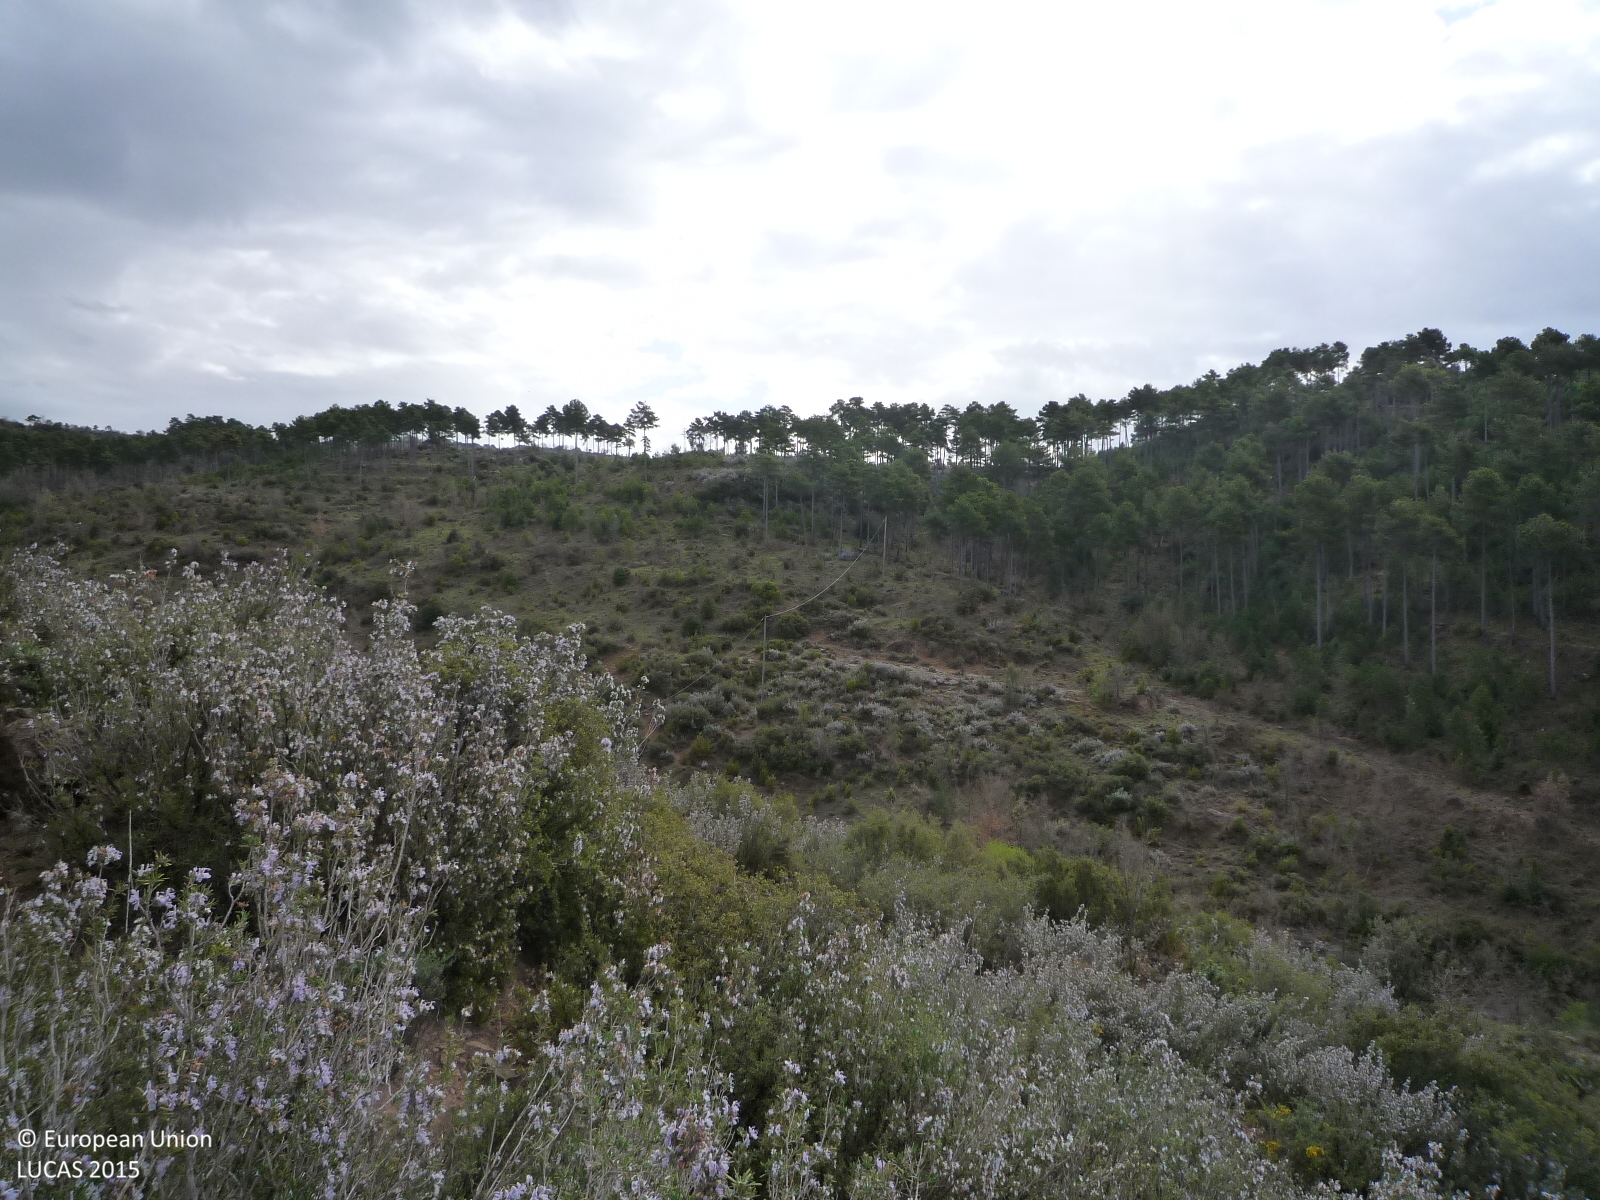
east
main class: Shrubland
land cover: Shrubland with sparse tree cover
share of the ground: > 75 %
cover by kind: shrubs 95 %, coniferous forest trees 5 %
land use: Semi-natural and natural areas not in use
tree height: < 5 m
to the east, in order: Shrubland with sparse tree cover; Tracks; Shrubland with sparse tree cover; Rivers and streams; Shrubland with sparse tree cover; Electric lines; Shrubland with sparse tree cover
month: April
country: ES
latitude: 41.9879
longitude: 1.7208
